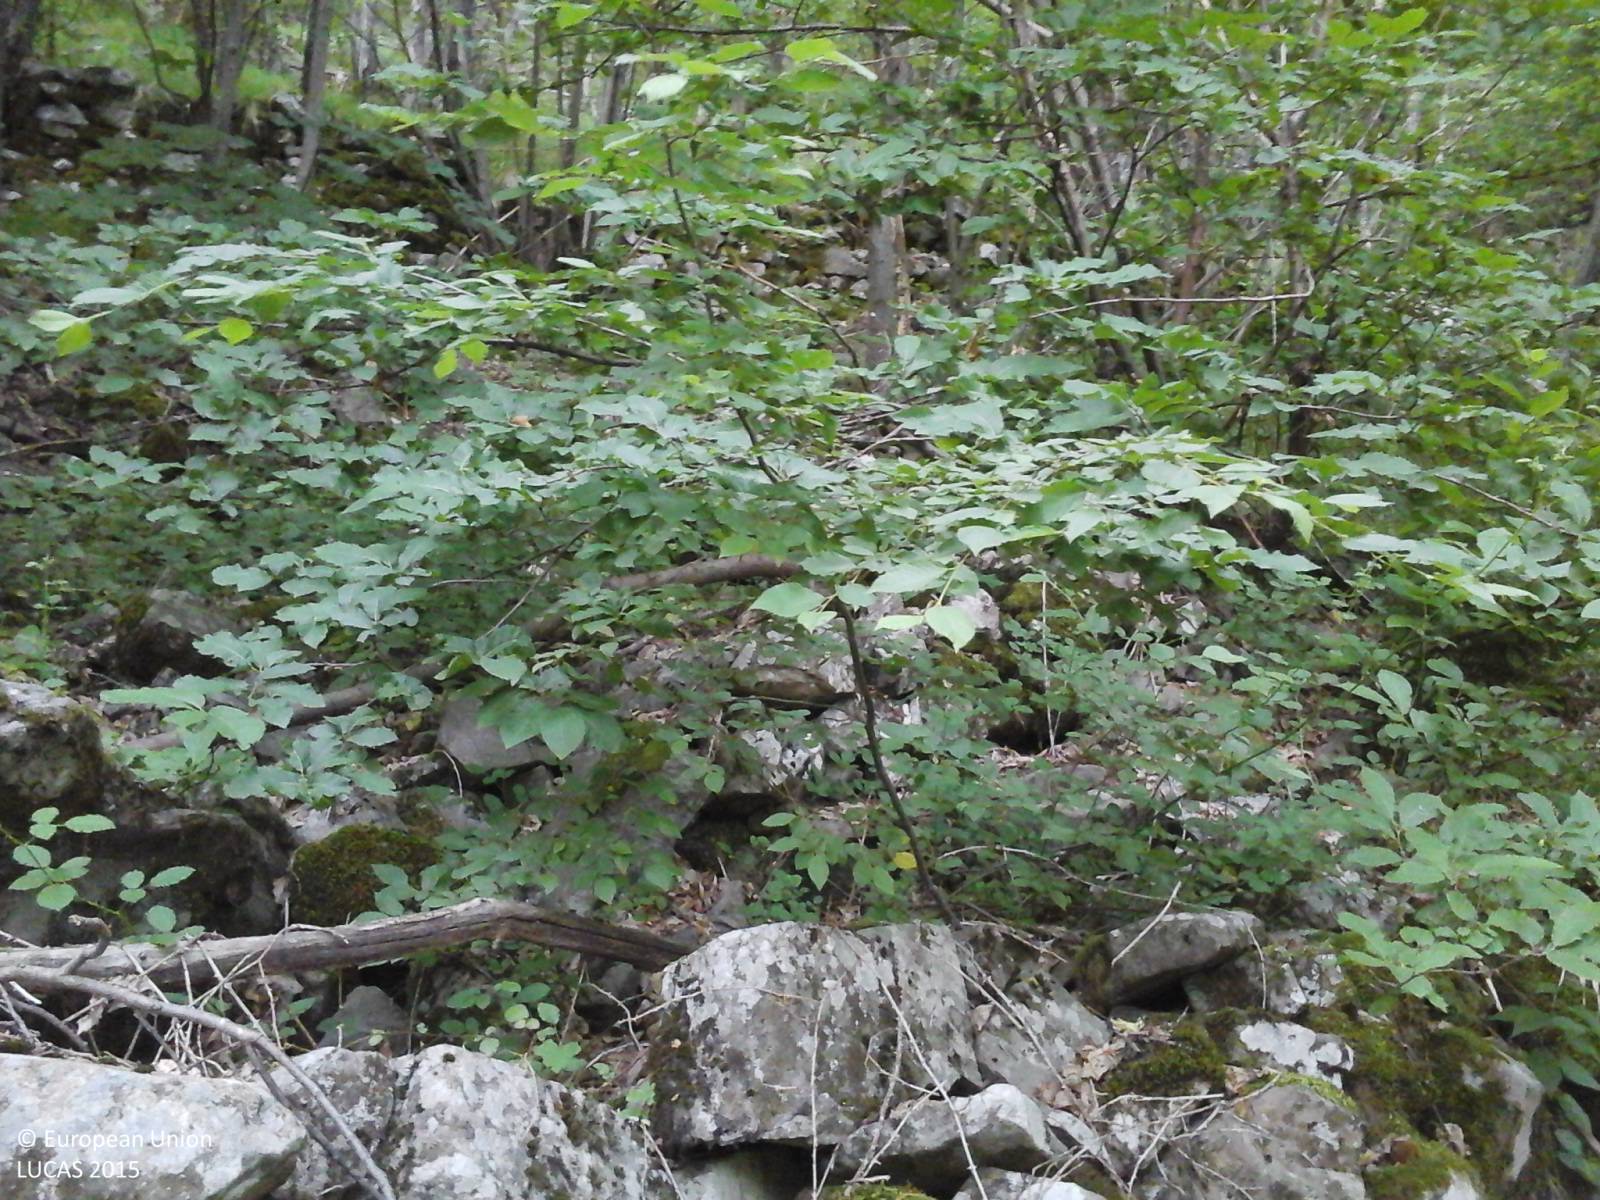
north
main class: Woodland
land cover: Broadleaved woodland
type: thermophilous deciduous forest
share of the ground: > 75 %
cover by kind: broadleaved forest trees 75 %, shrubs 25 %
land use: Forestry
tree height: > 5 m
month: June
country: IT
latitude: 44.1317
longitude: 10.7107
